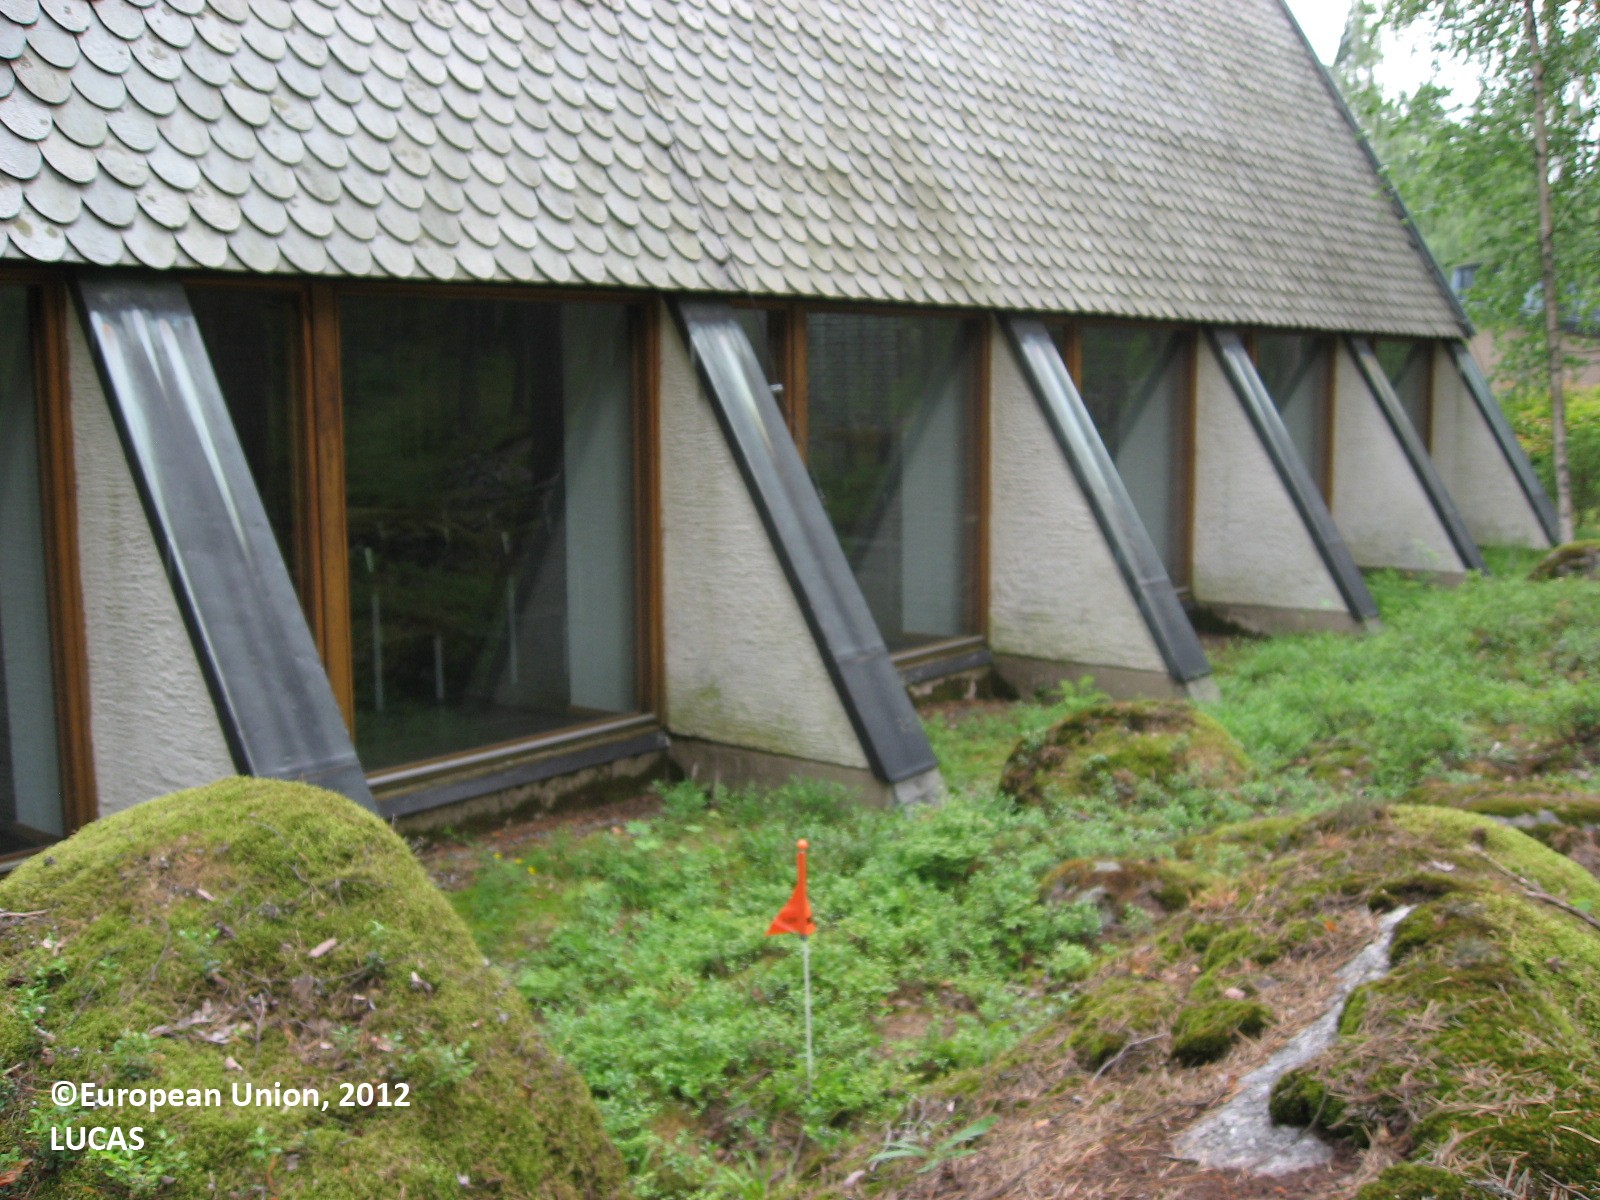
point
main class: Woodland
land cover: Pine dominated coniferous woodland
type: boreal forest
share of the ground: 50 - 75 %
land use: Community services
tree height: > 5 m
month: July
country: FI
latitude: 60.9650
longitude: 25.7392
